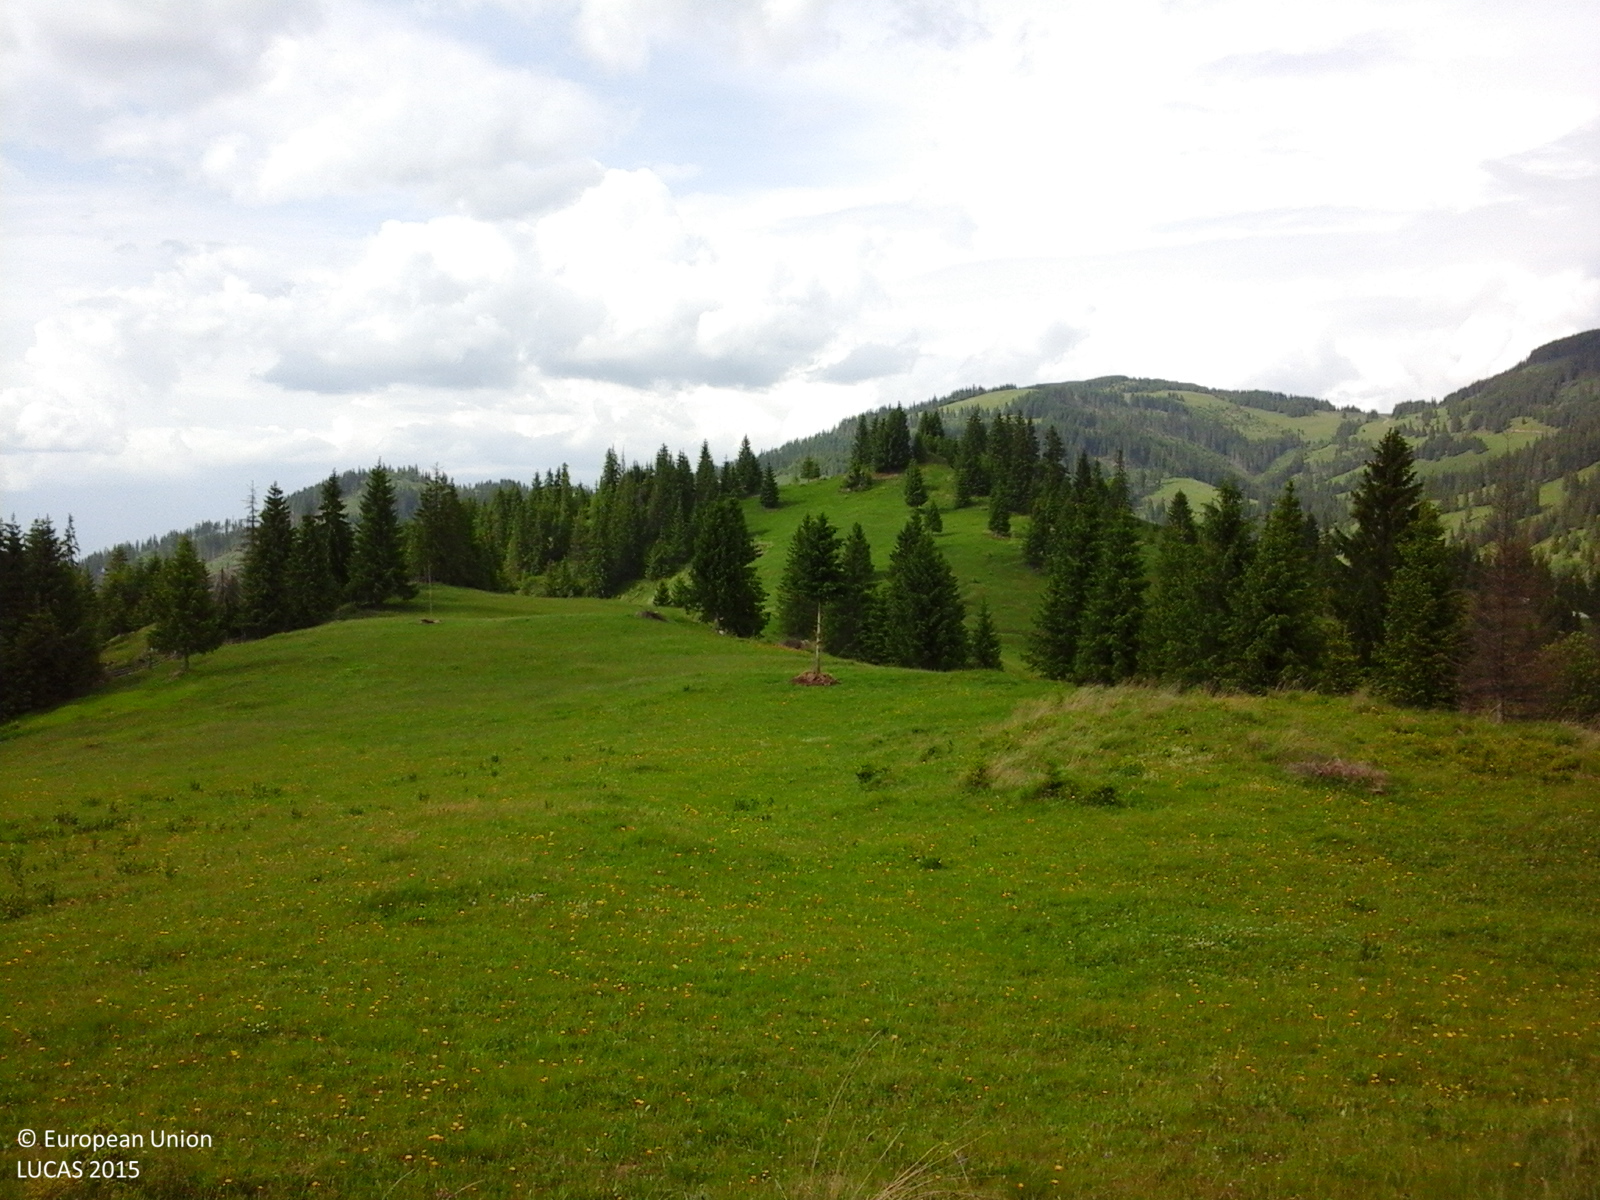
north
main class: Grassland
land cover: Grassland without tree/shrub cover
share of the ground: > 75 %
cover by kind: herbaceous plants 100 %
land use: Agriculture (excluding fallow land and kitchen gardens)
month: June
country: RO
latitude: 47.1831
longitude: 25.4331
